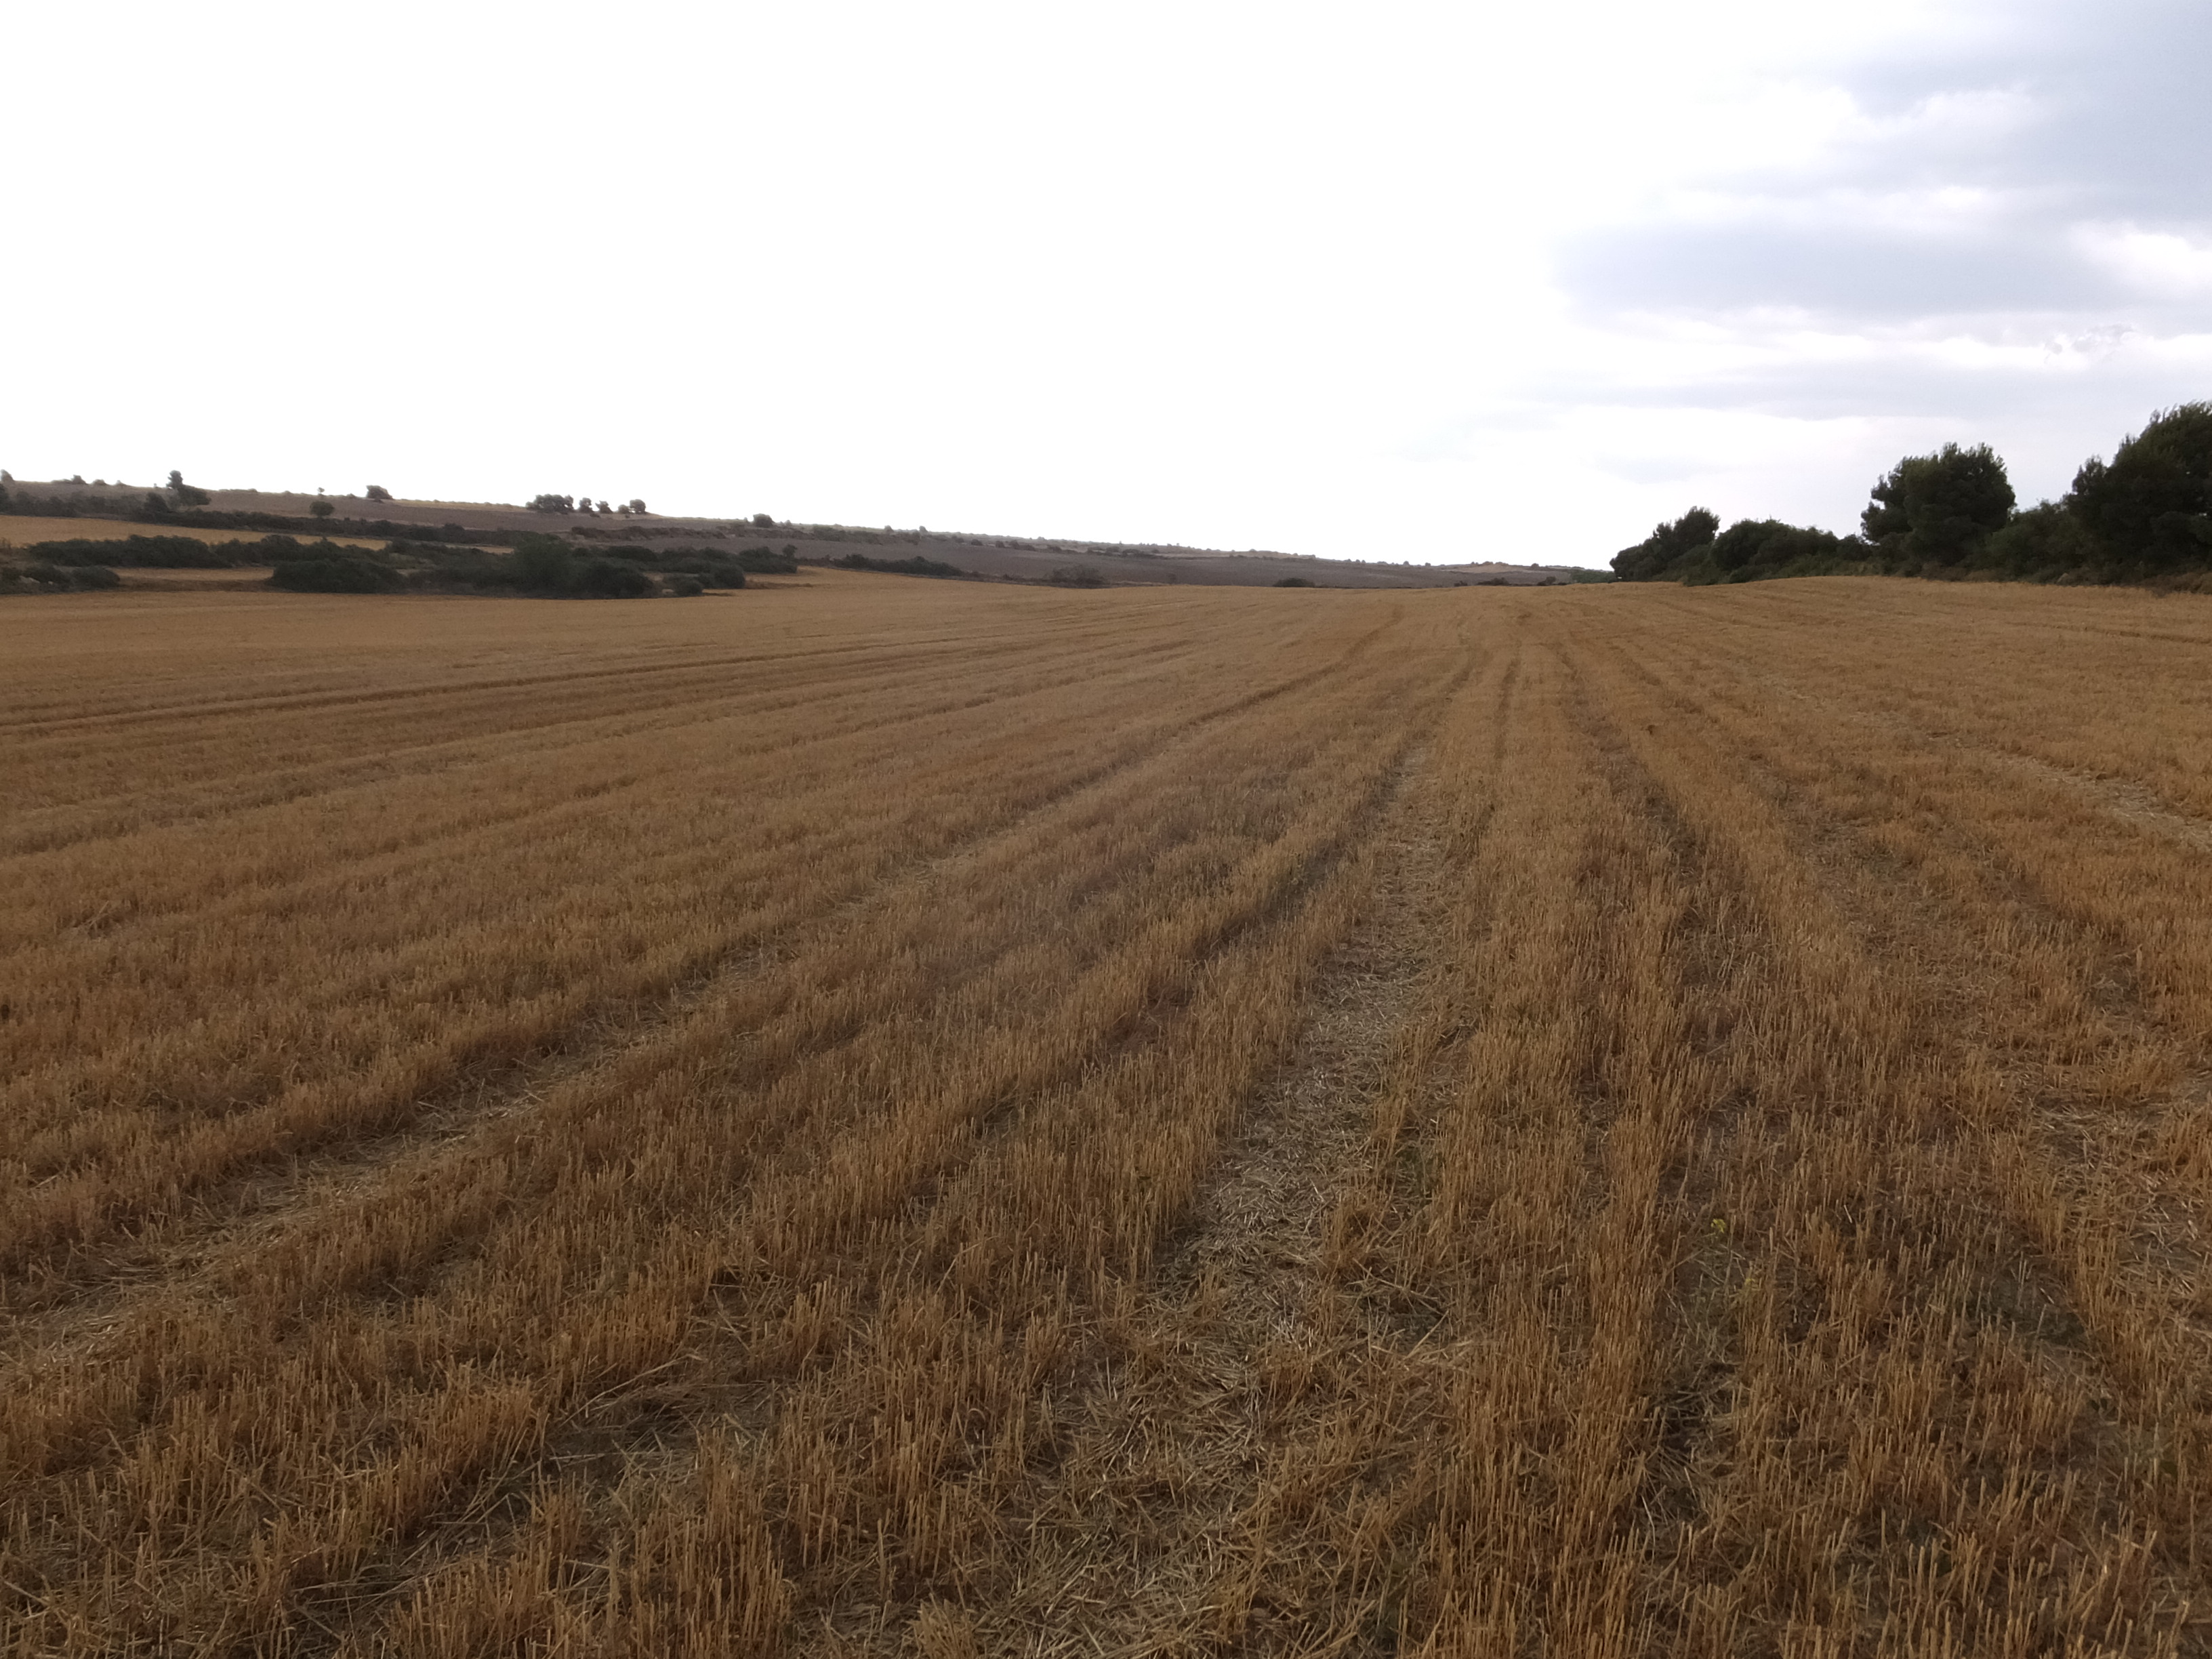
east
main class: Cropland
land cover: Barley
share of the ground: < 10 %
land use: Agriculture (excluding fallow land and kitchen gardens)
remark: Harvested field
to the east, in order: Barley
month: June
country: ES
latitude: 41.4222
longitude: 0.2839
